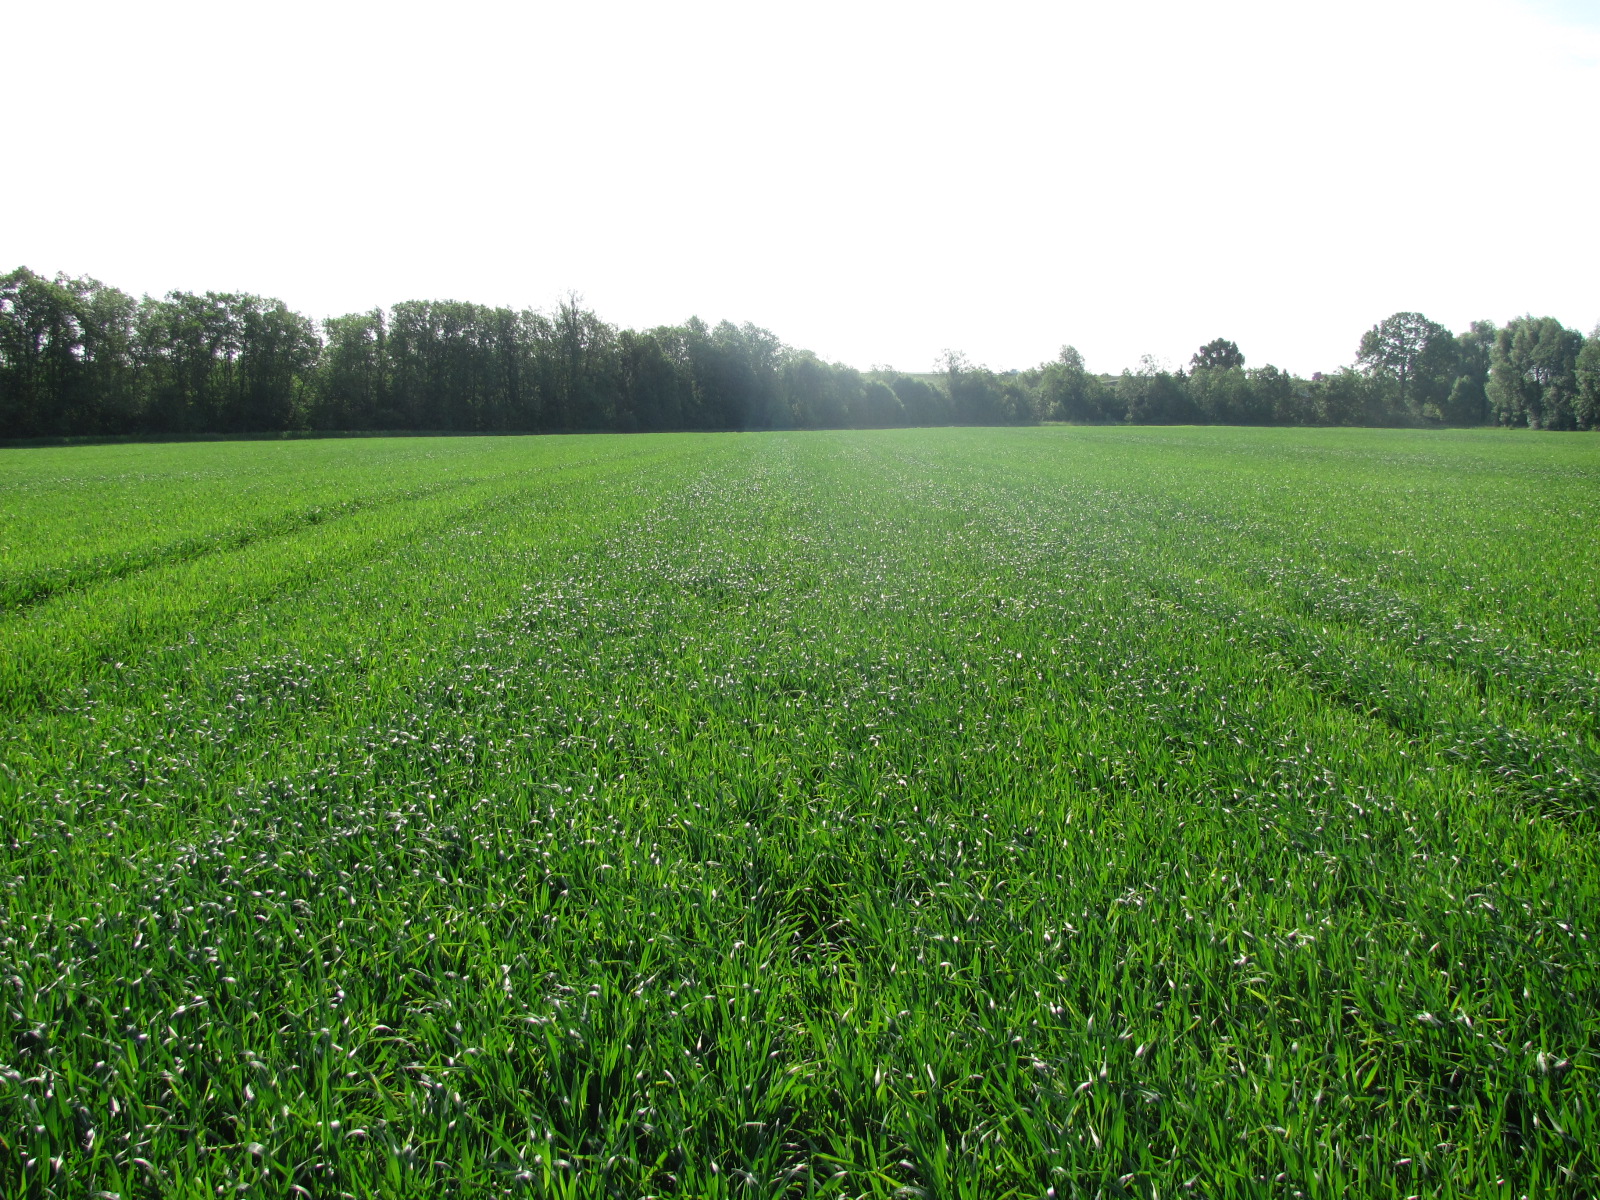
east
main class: Cropland
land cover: Common wheat
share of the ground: > 75 %
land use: Agriculture (excluding fallow land and kitchen gardens)
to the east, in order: Common wheat; Grass margins; Broadleaved woodland; Rivers and streams
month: June
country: LV
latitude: 56.8305
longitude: 24.2651
